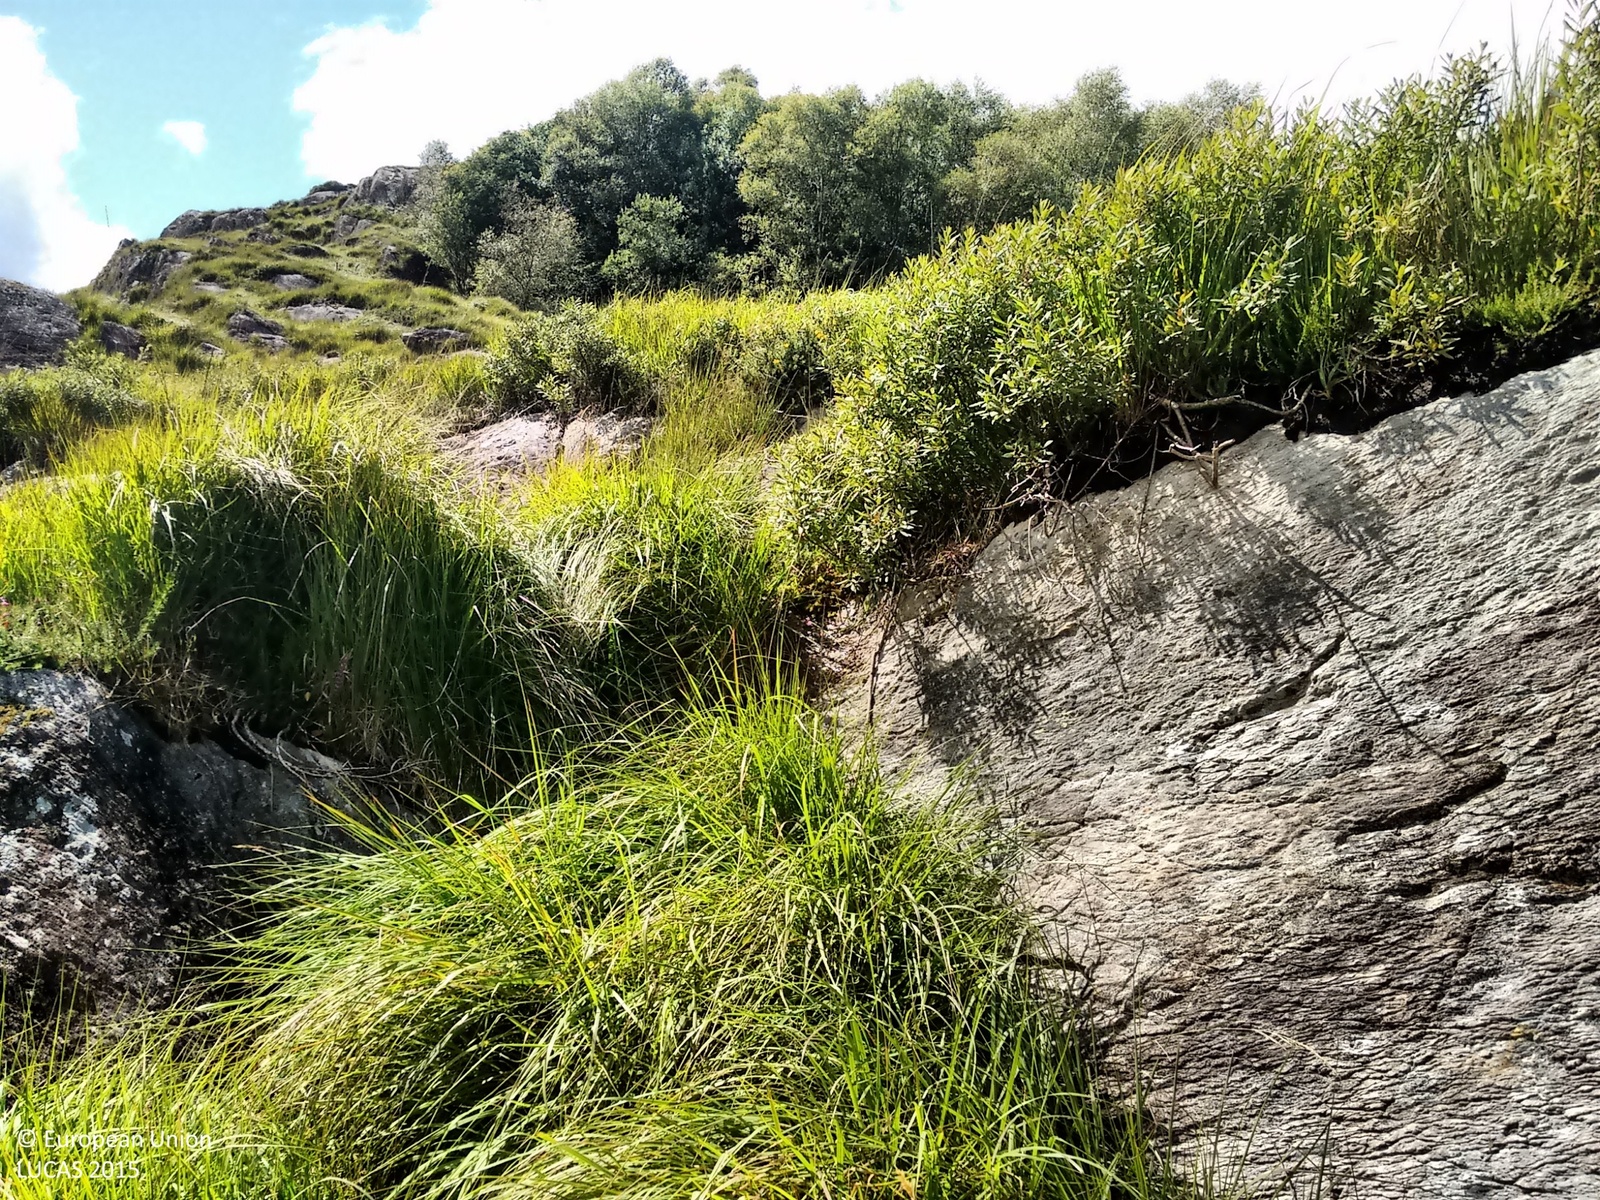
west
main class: Grassland
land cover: Grassland without tree/shrub cover
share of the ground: > 75 %
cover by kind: herbaceous plants 60 %, consolidated bare surface 40 %
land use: Semi-natural and natural areas not in use
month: August
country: IE
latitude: 51.7406
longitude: -9.4786
